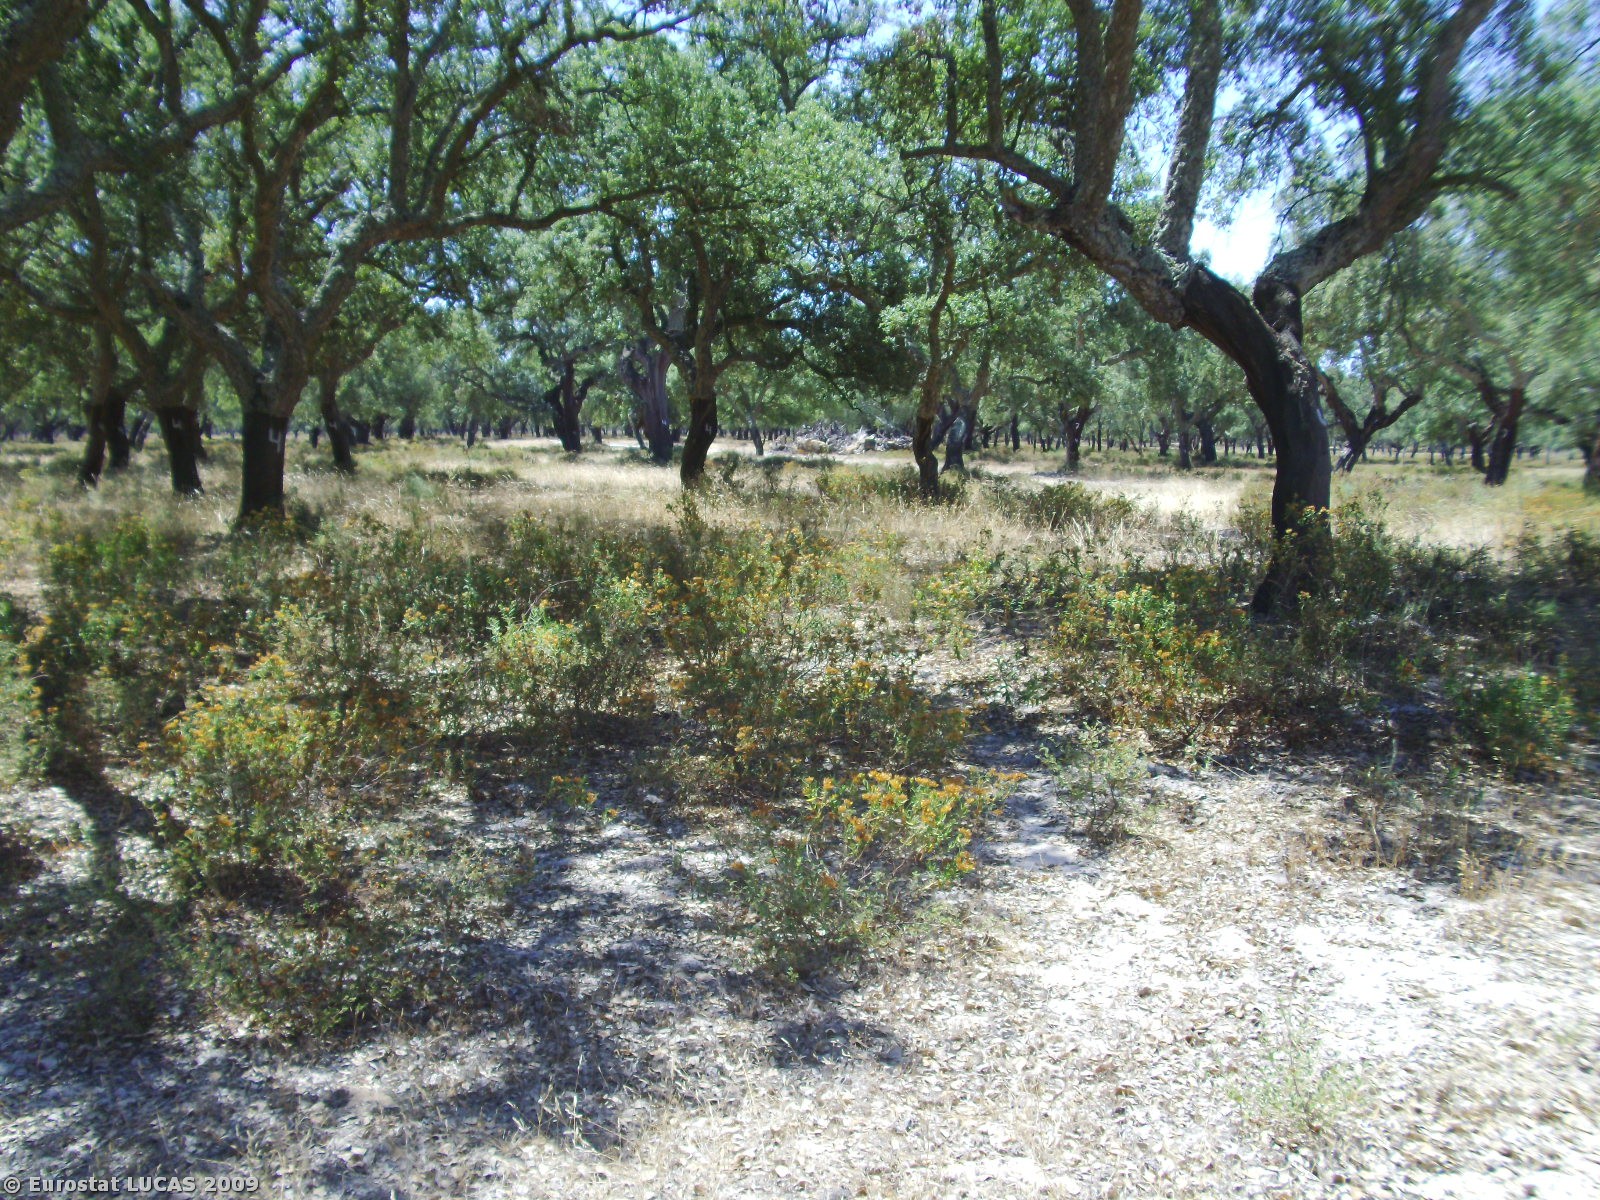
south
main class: Woodland
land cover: Broadleaved woodland
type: broadleaved evergreen forest
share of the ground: 10 - 25 %
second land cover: Spontaneously vegetated surfaces
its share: 50 - 75 %
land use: Forestry
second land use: Fallow land
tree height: > 5 m
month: August
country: PT
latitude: 38.7311
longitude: -8.8757
